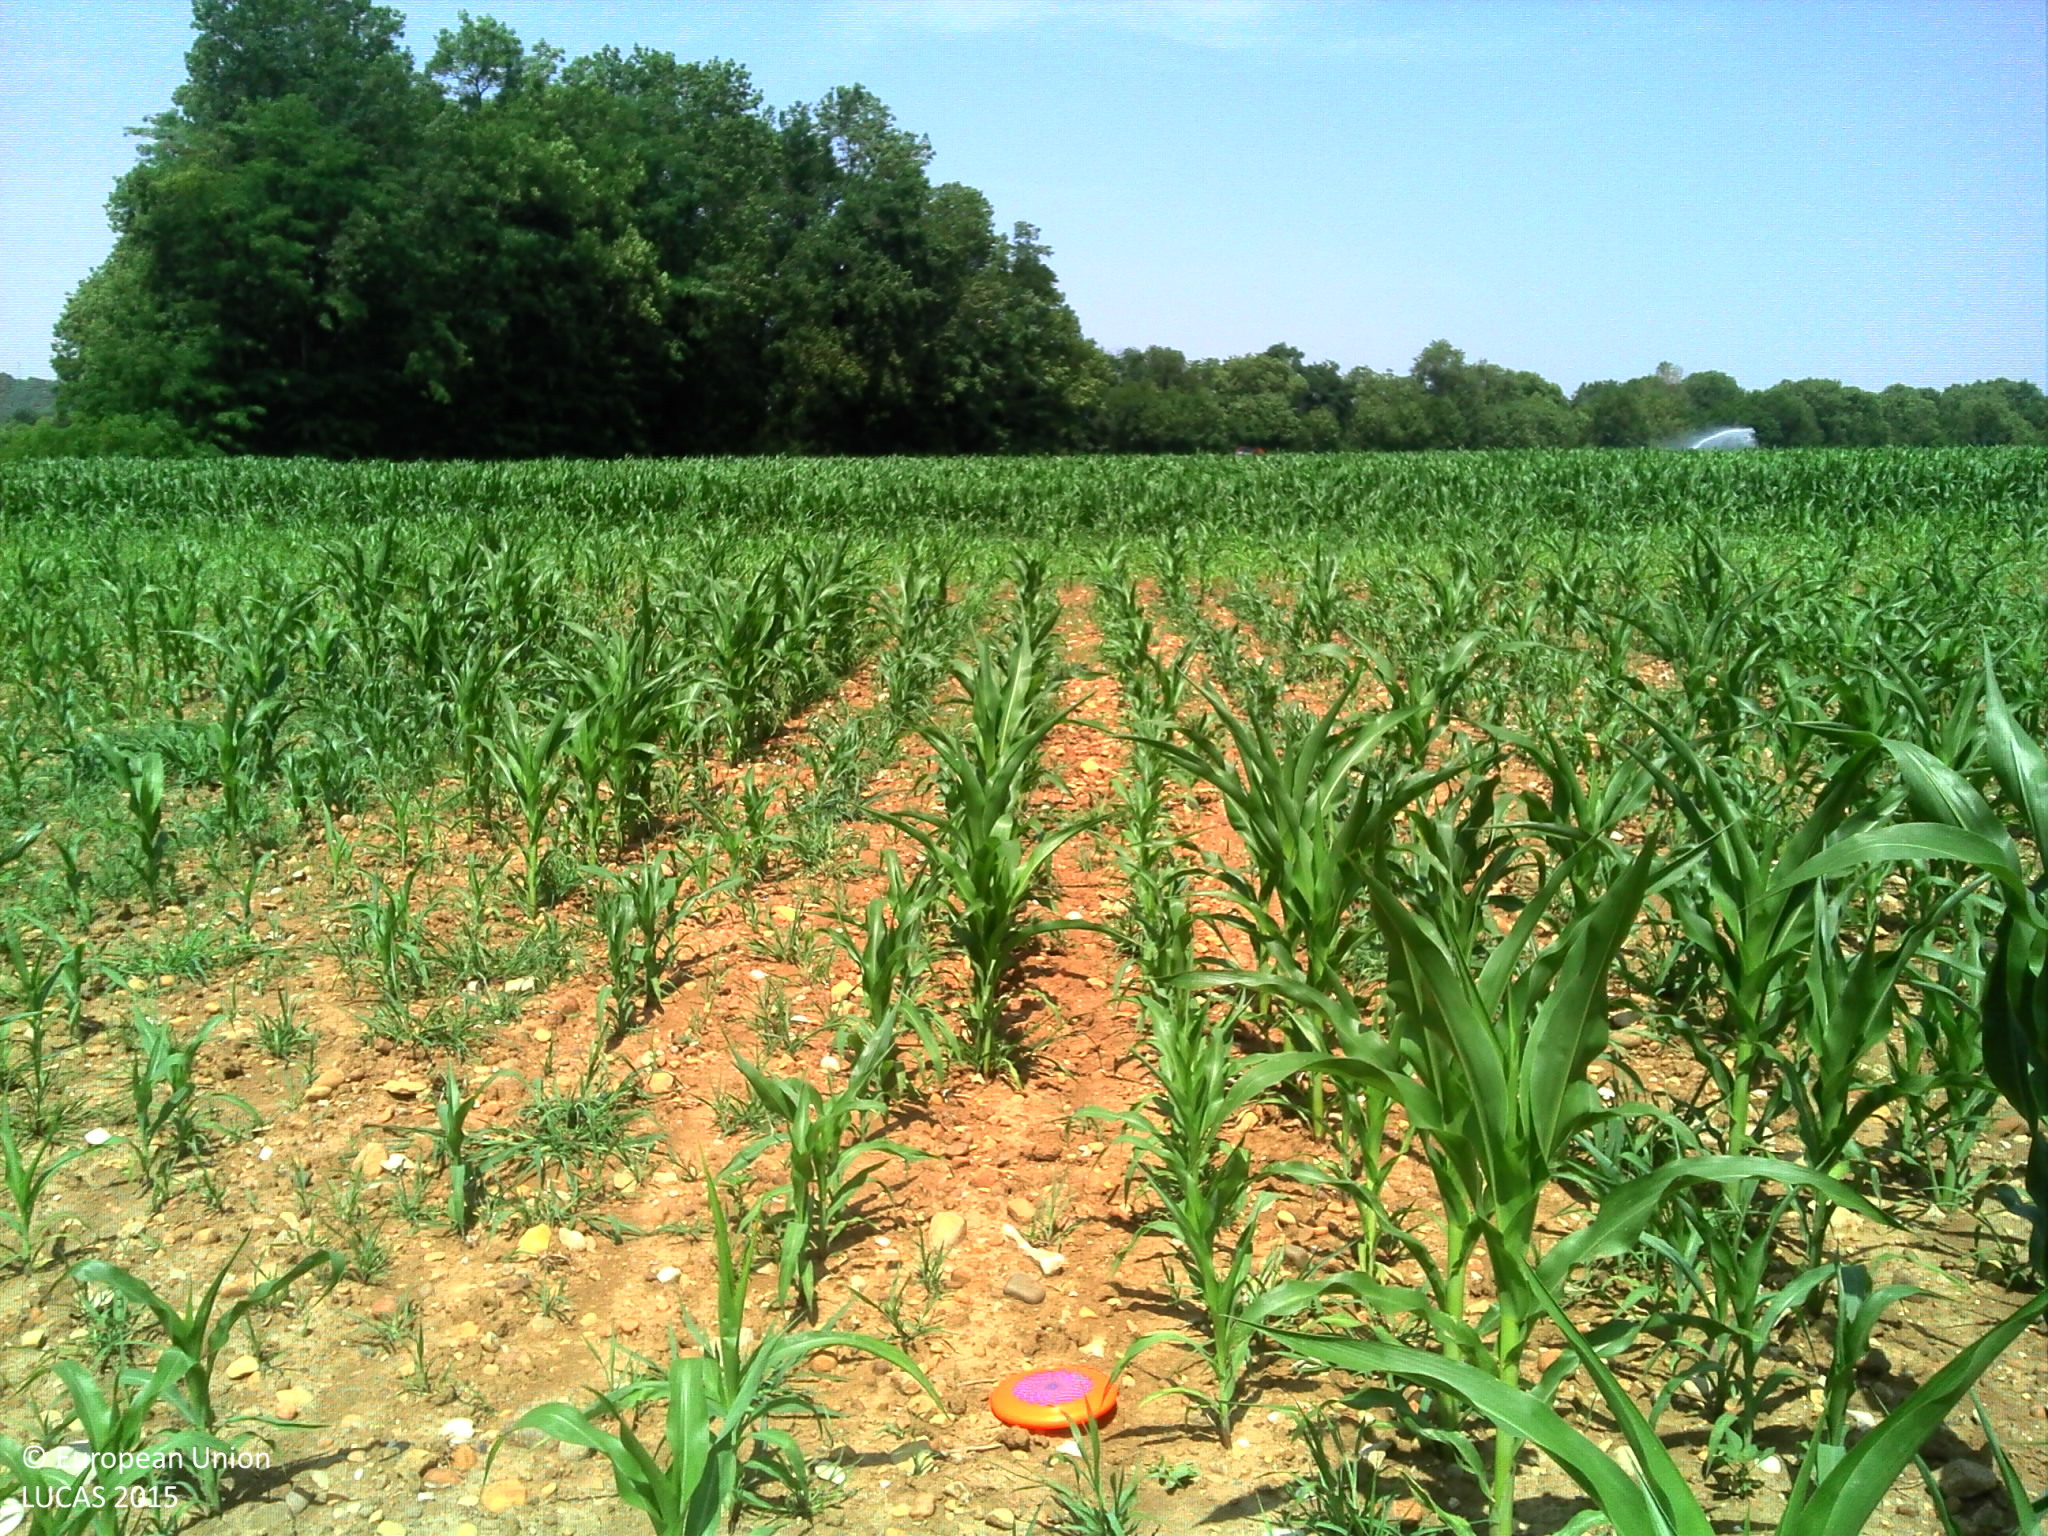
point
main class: Cropland
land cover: Maize
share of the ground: 25 - 50 %
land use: Agriculture (excluding fallow land and kitchen gardens)
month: July
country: FR
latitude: 45.8174
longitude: 5.3578
